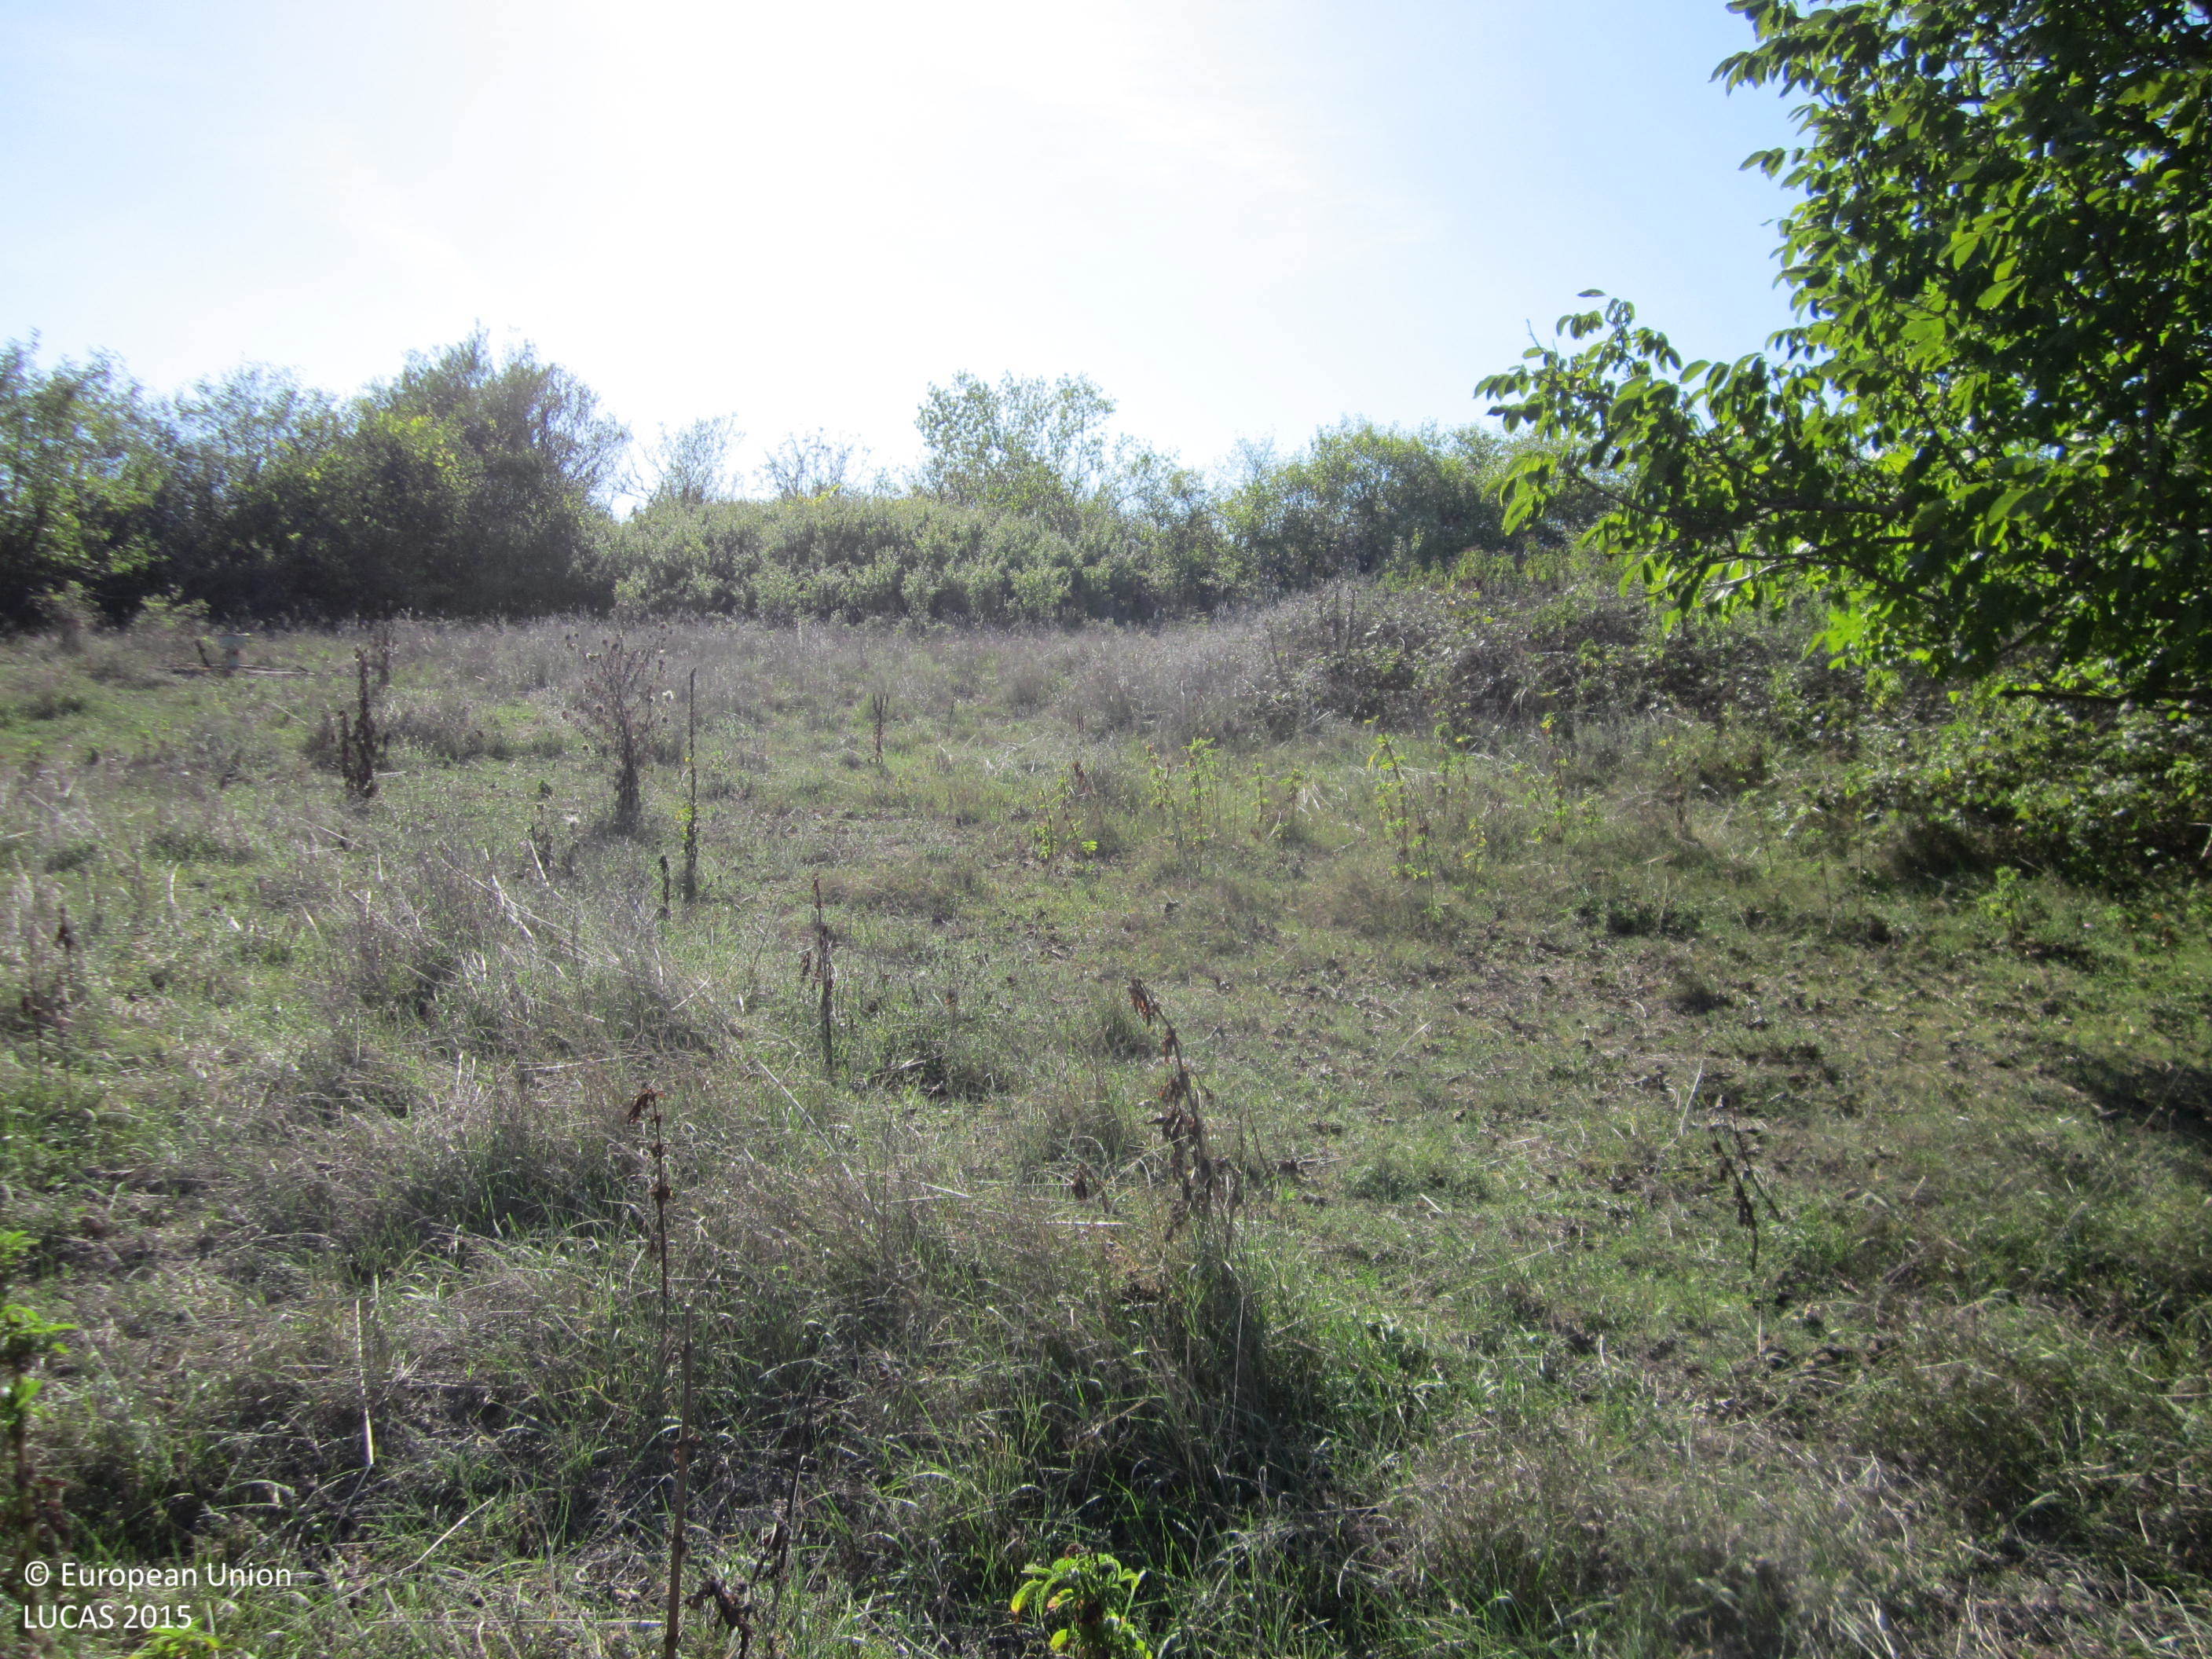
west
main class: Grassland
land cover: Grassland with sparse tree/shrub cover
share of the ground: > 75 %
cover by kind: herbaceous plants 85 %, shrubs 10 %, broadleaved forest trees 5 %
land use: Abandoned areas
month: September
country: BG
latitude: 42.2618
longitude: 27.0625
